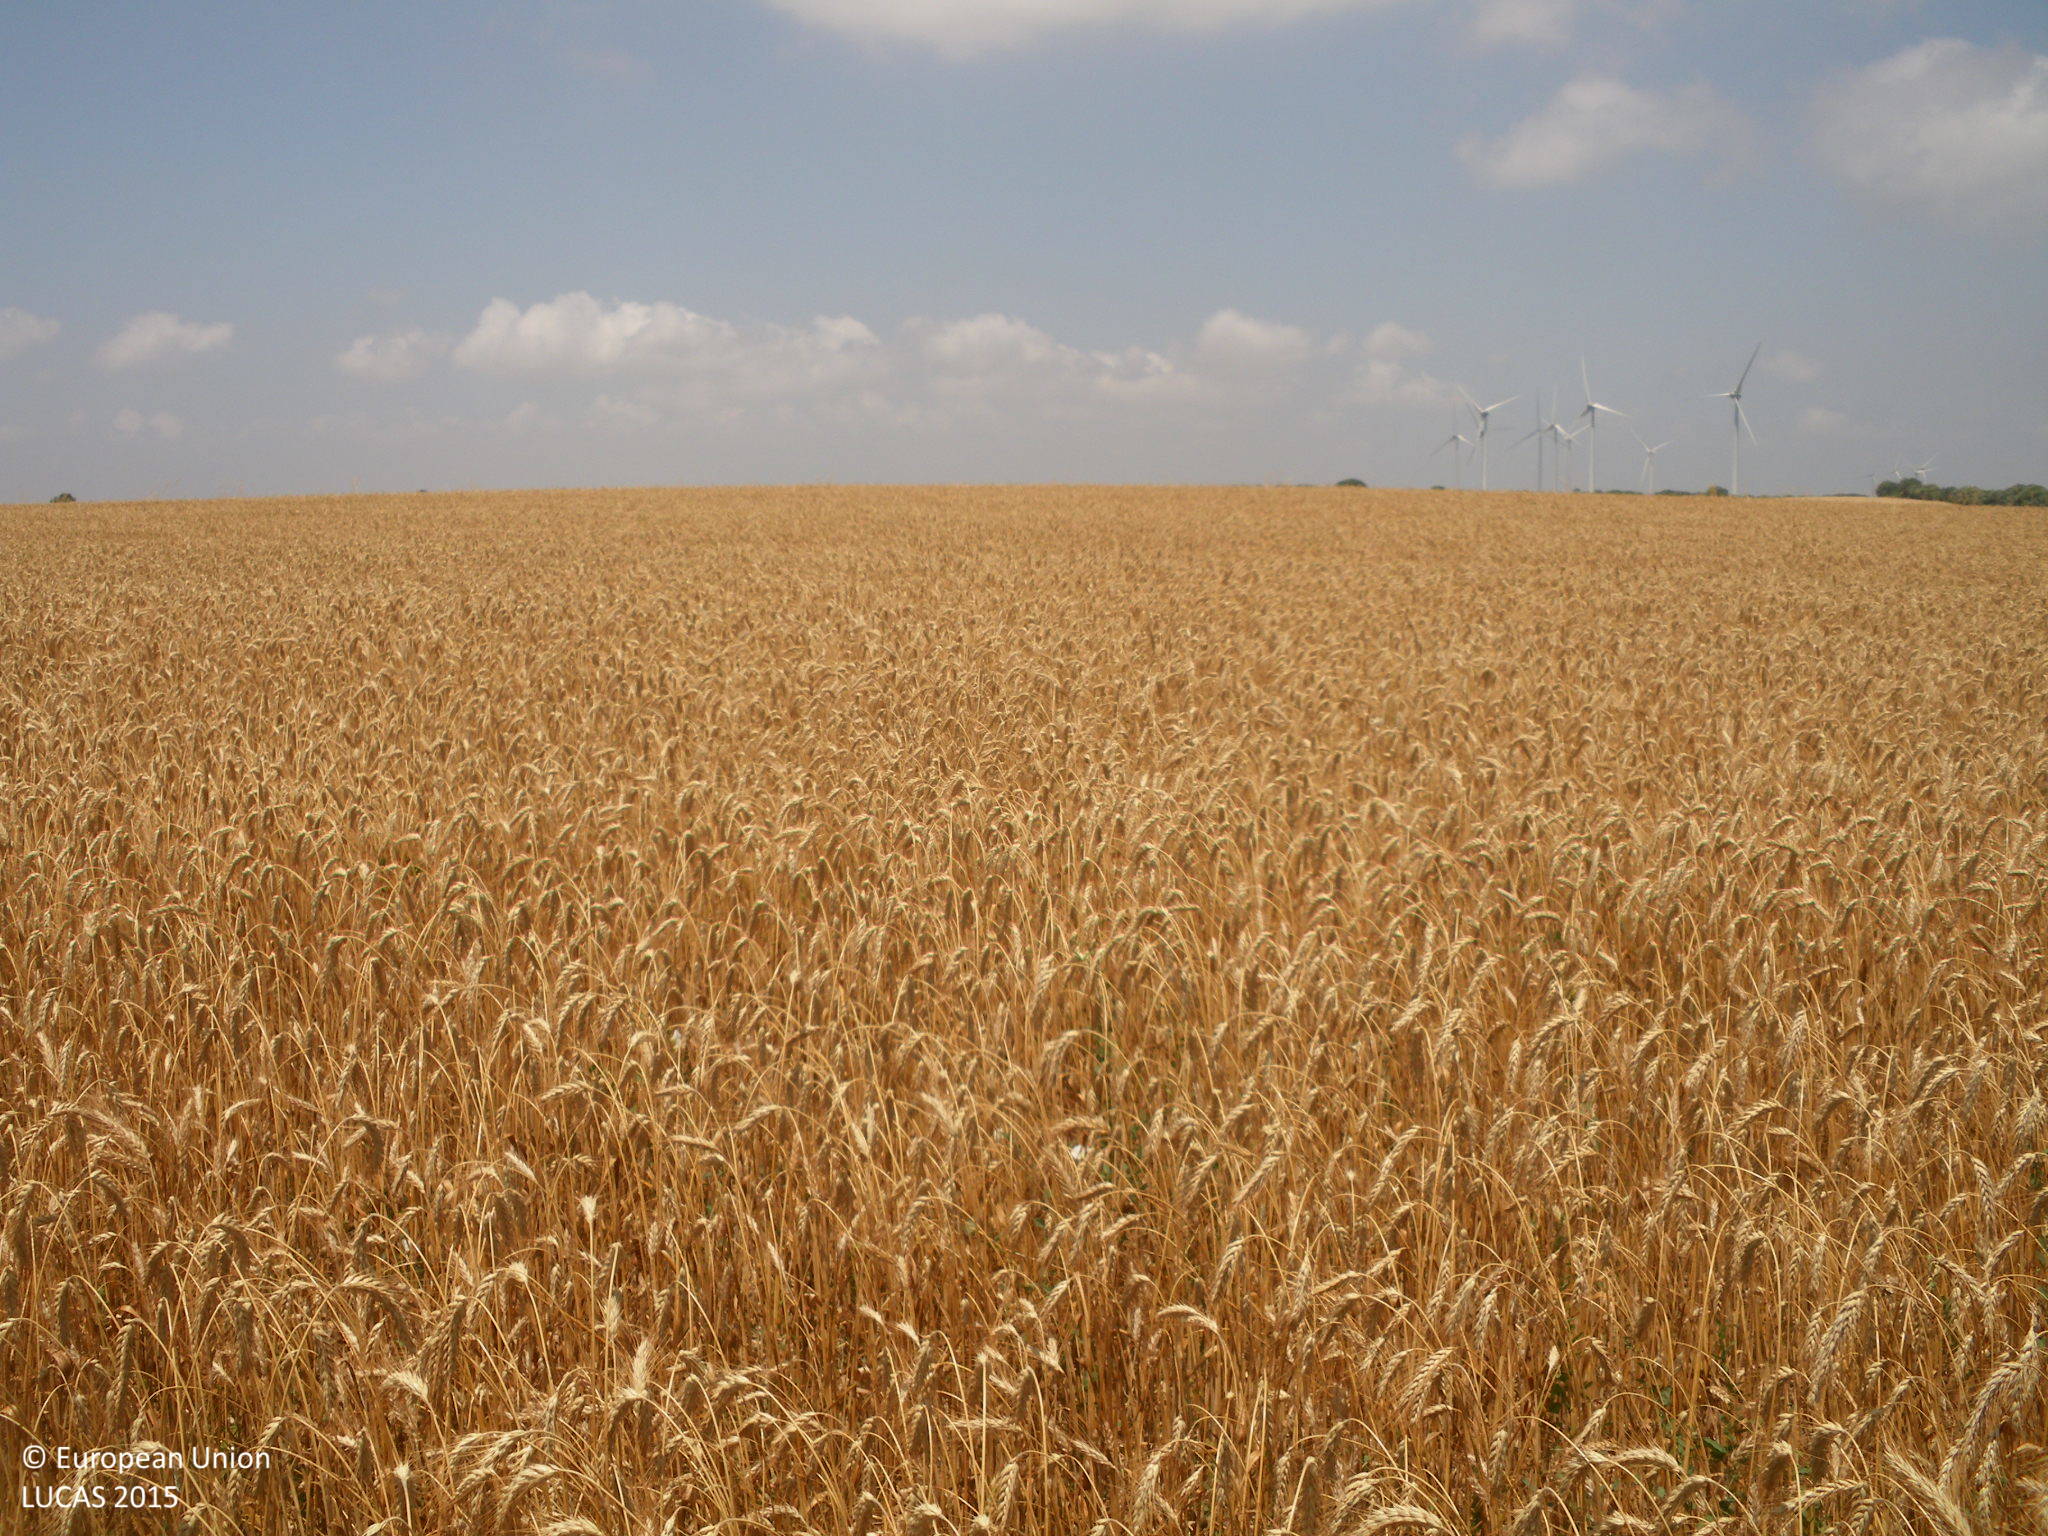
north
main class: Cropland
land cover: Common wheat
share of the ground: > 75 %
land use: Agriculture (excluding fallow land and kitchen gardens)
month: May
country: ES
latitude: 36.5137
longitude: -6.0988
